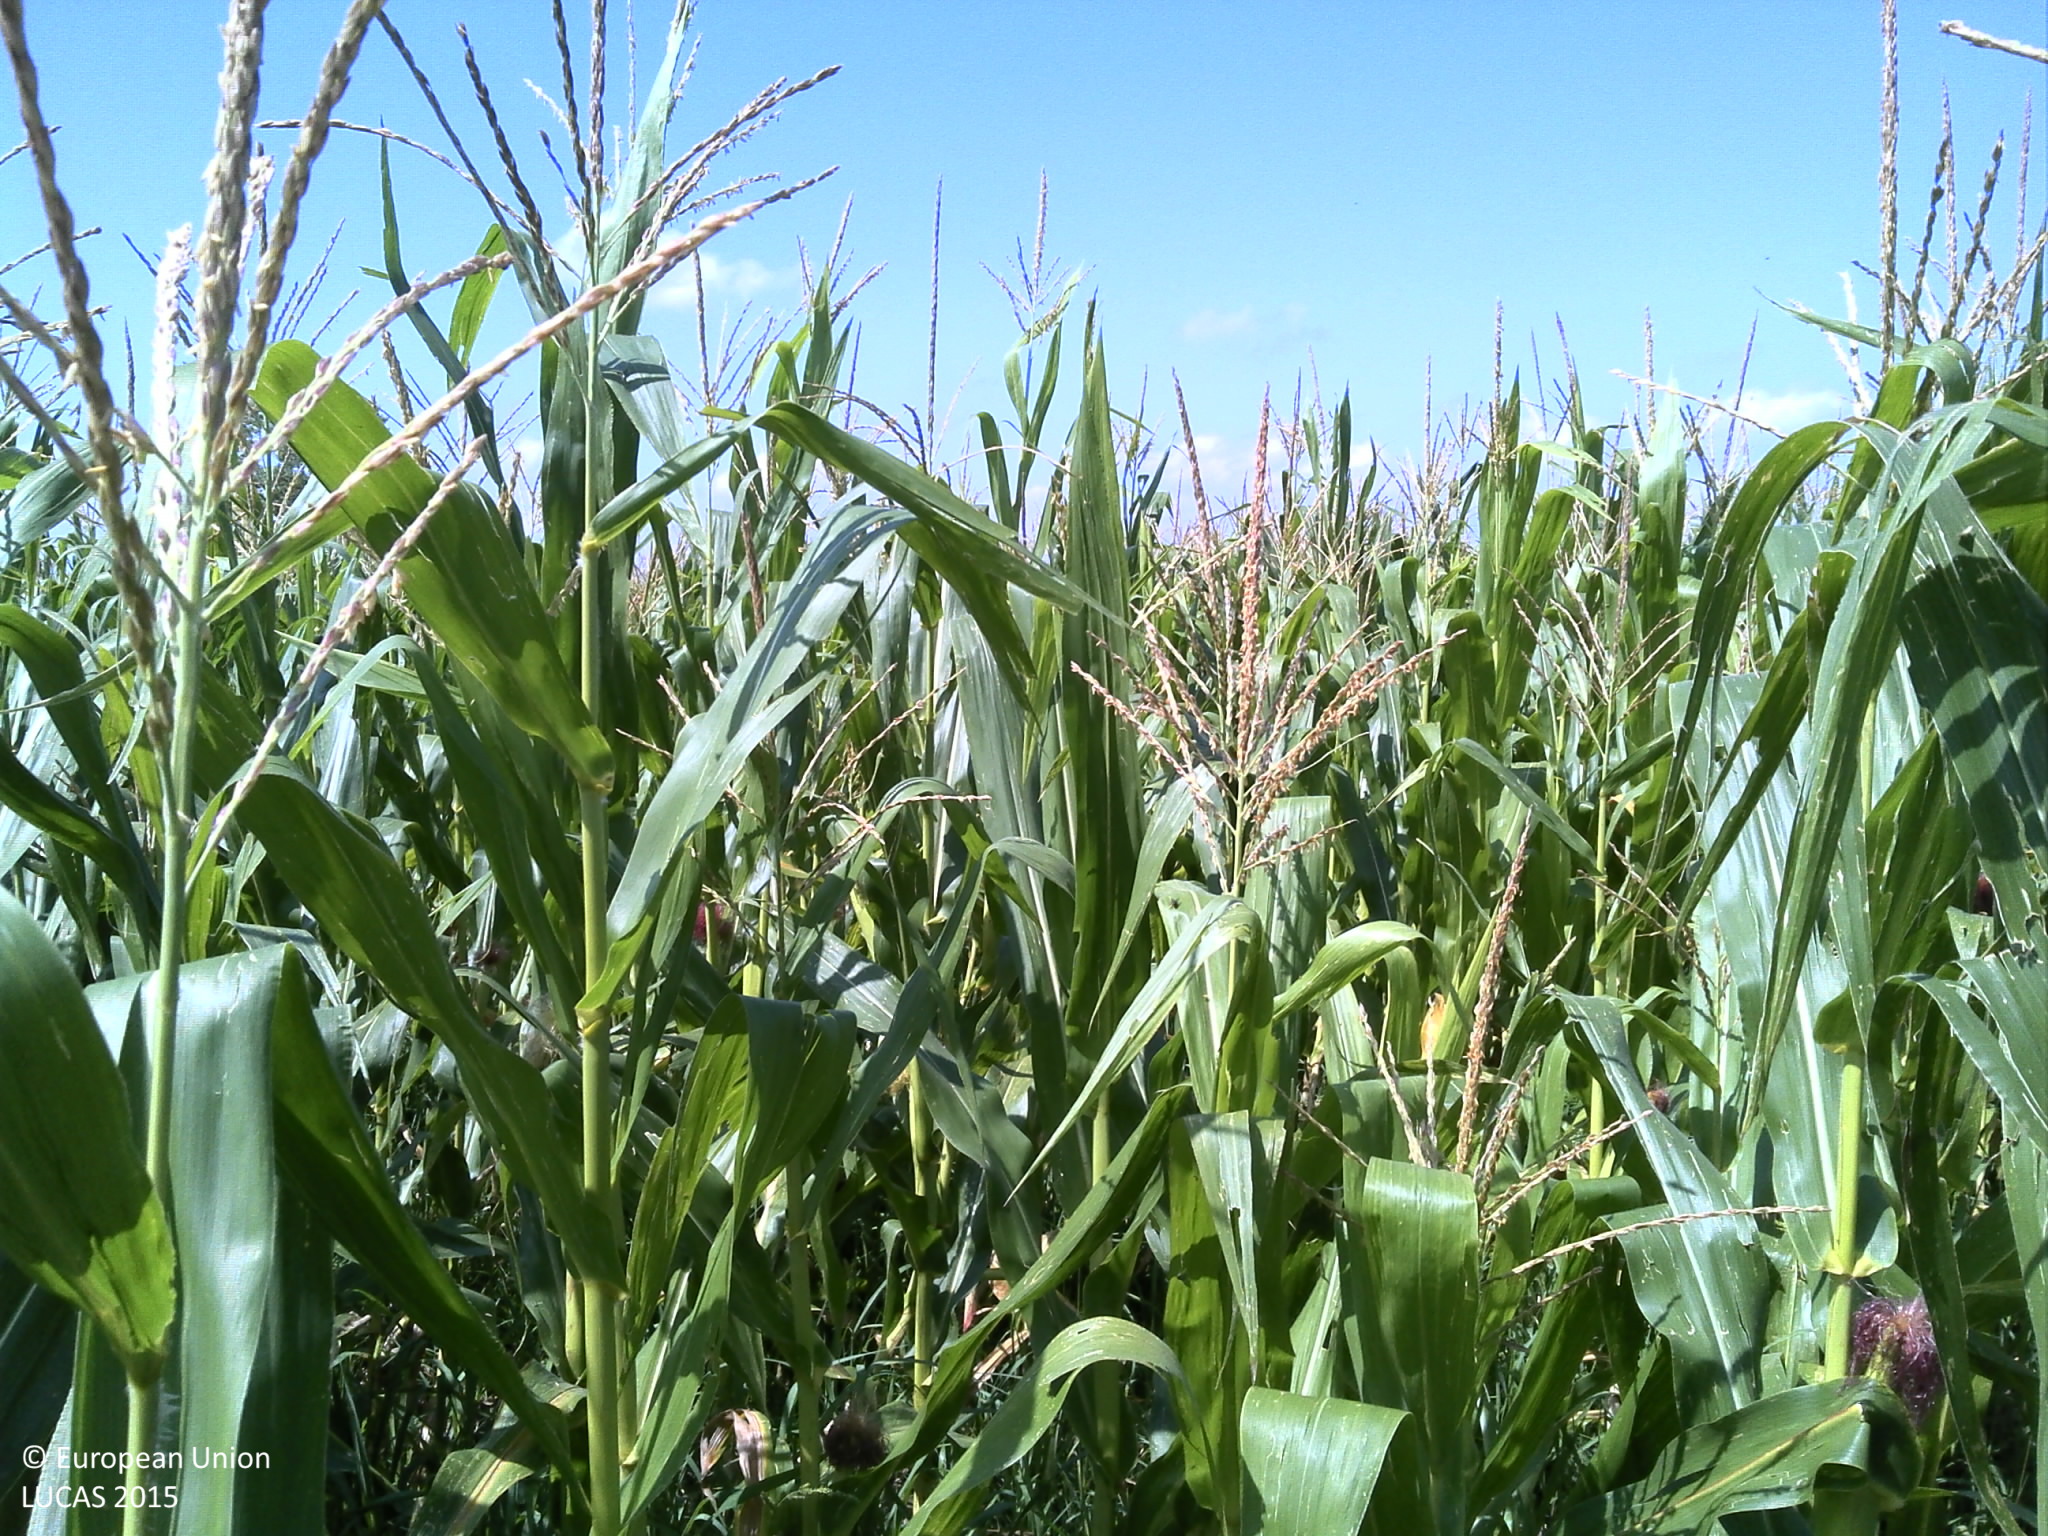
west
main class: Cropland
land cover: Maize
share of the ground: > 75 %
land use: Agriculture (excluding fallow land and kitchen gardens)
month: August
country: HR
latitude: 45.5528
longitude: 16.5699
